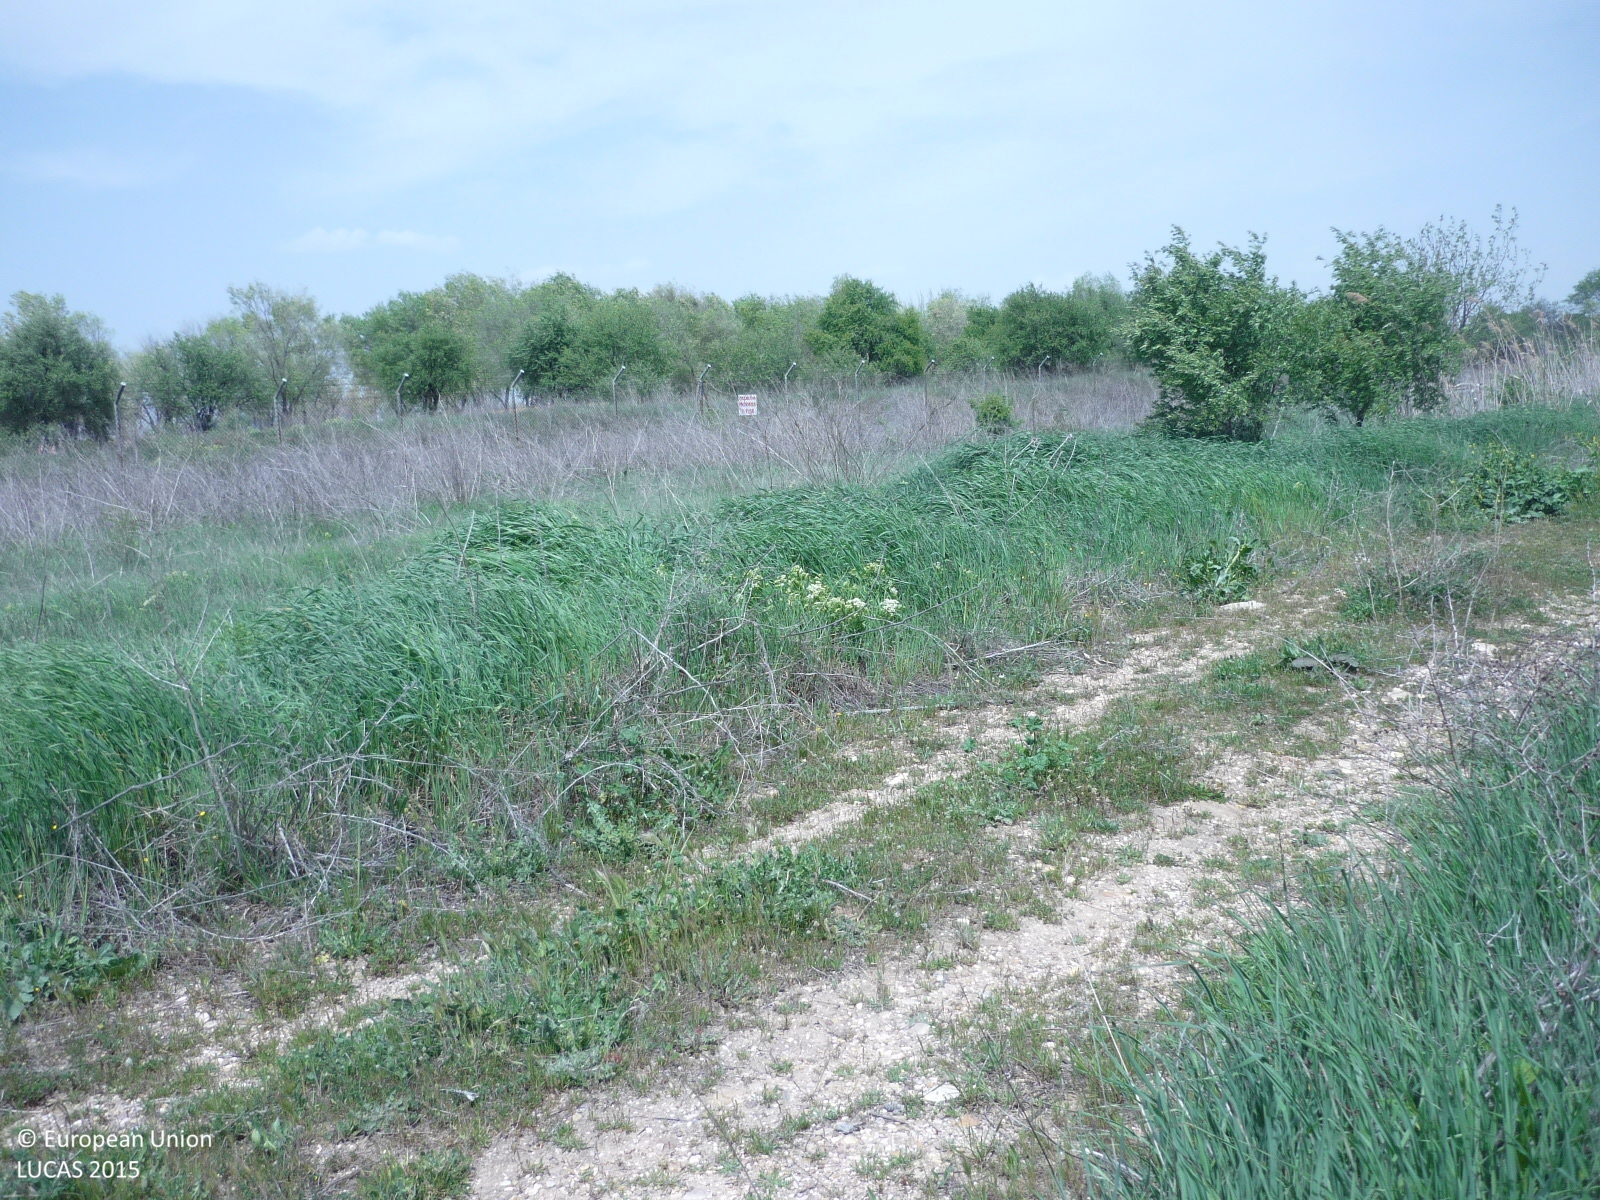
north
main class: Grassland
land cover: Grassland without tree/shrub cover
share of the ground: > 75 %
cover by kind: herbaceous plants 80 %, consolidated bare surface 20 %
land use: Abandoned areas
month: April
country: ES
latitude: 40.4724
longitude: -3.4457
